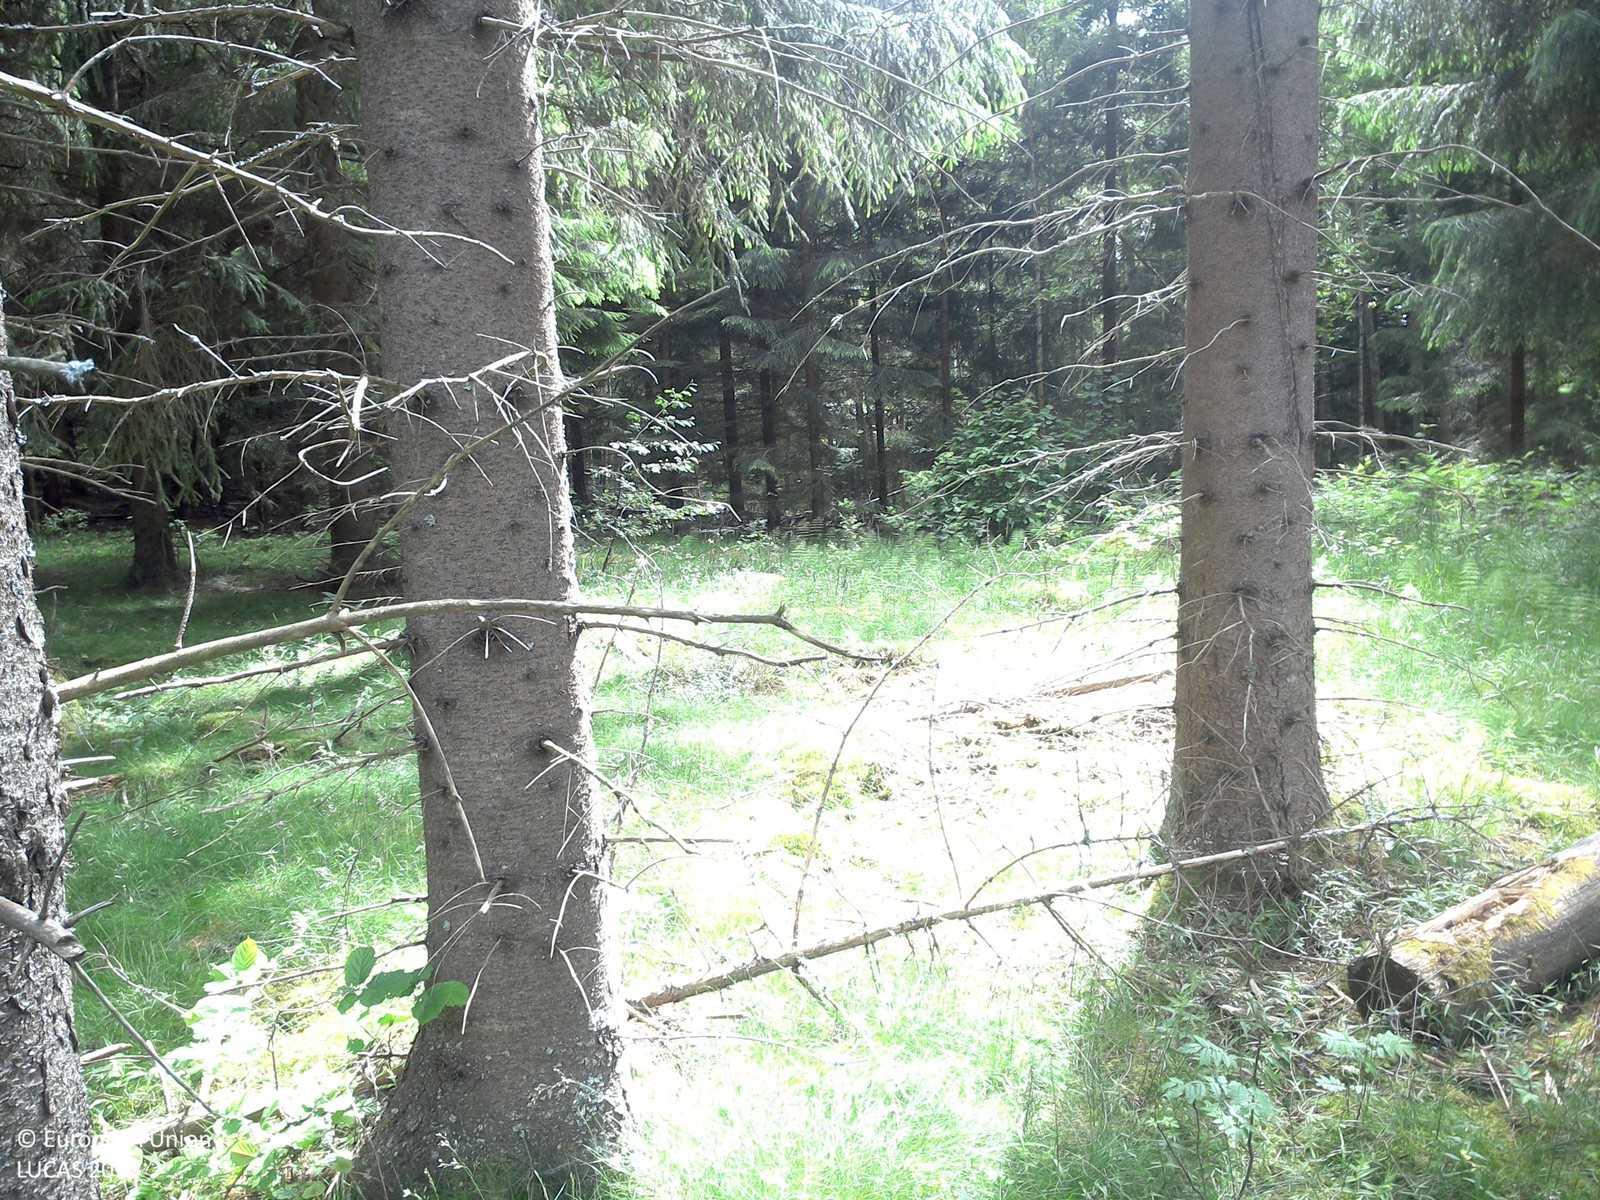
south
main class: Woodland
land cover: Spruce dominated coniferous woodland
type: boreal forest
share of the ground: > 75 %
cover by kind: coniferous forest trees 75 %, herbaceous plants 25 %
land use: Forestry
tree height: > 5 m
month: June
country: SE
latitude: 58.2665
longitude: 15.5690
